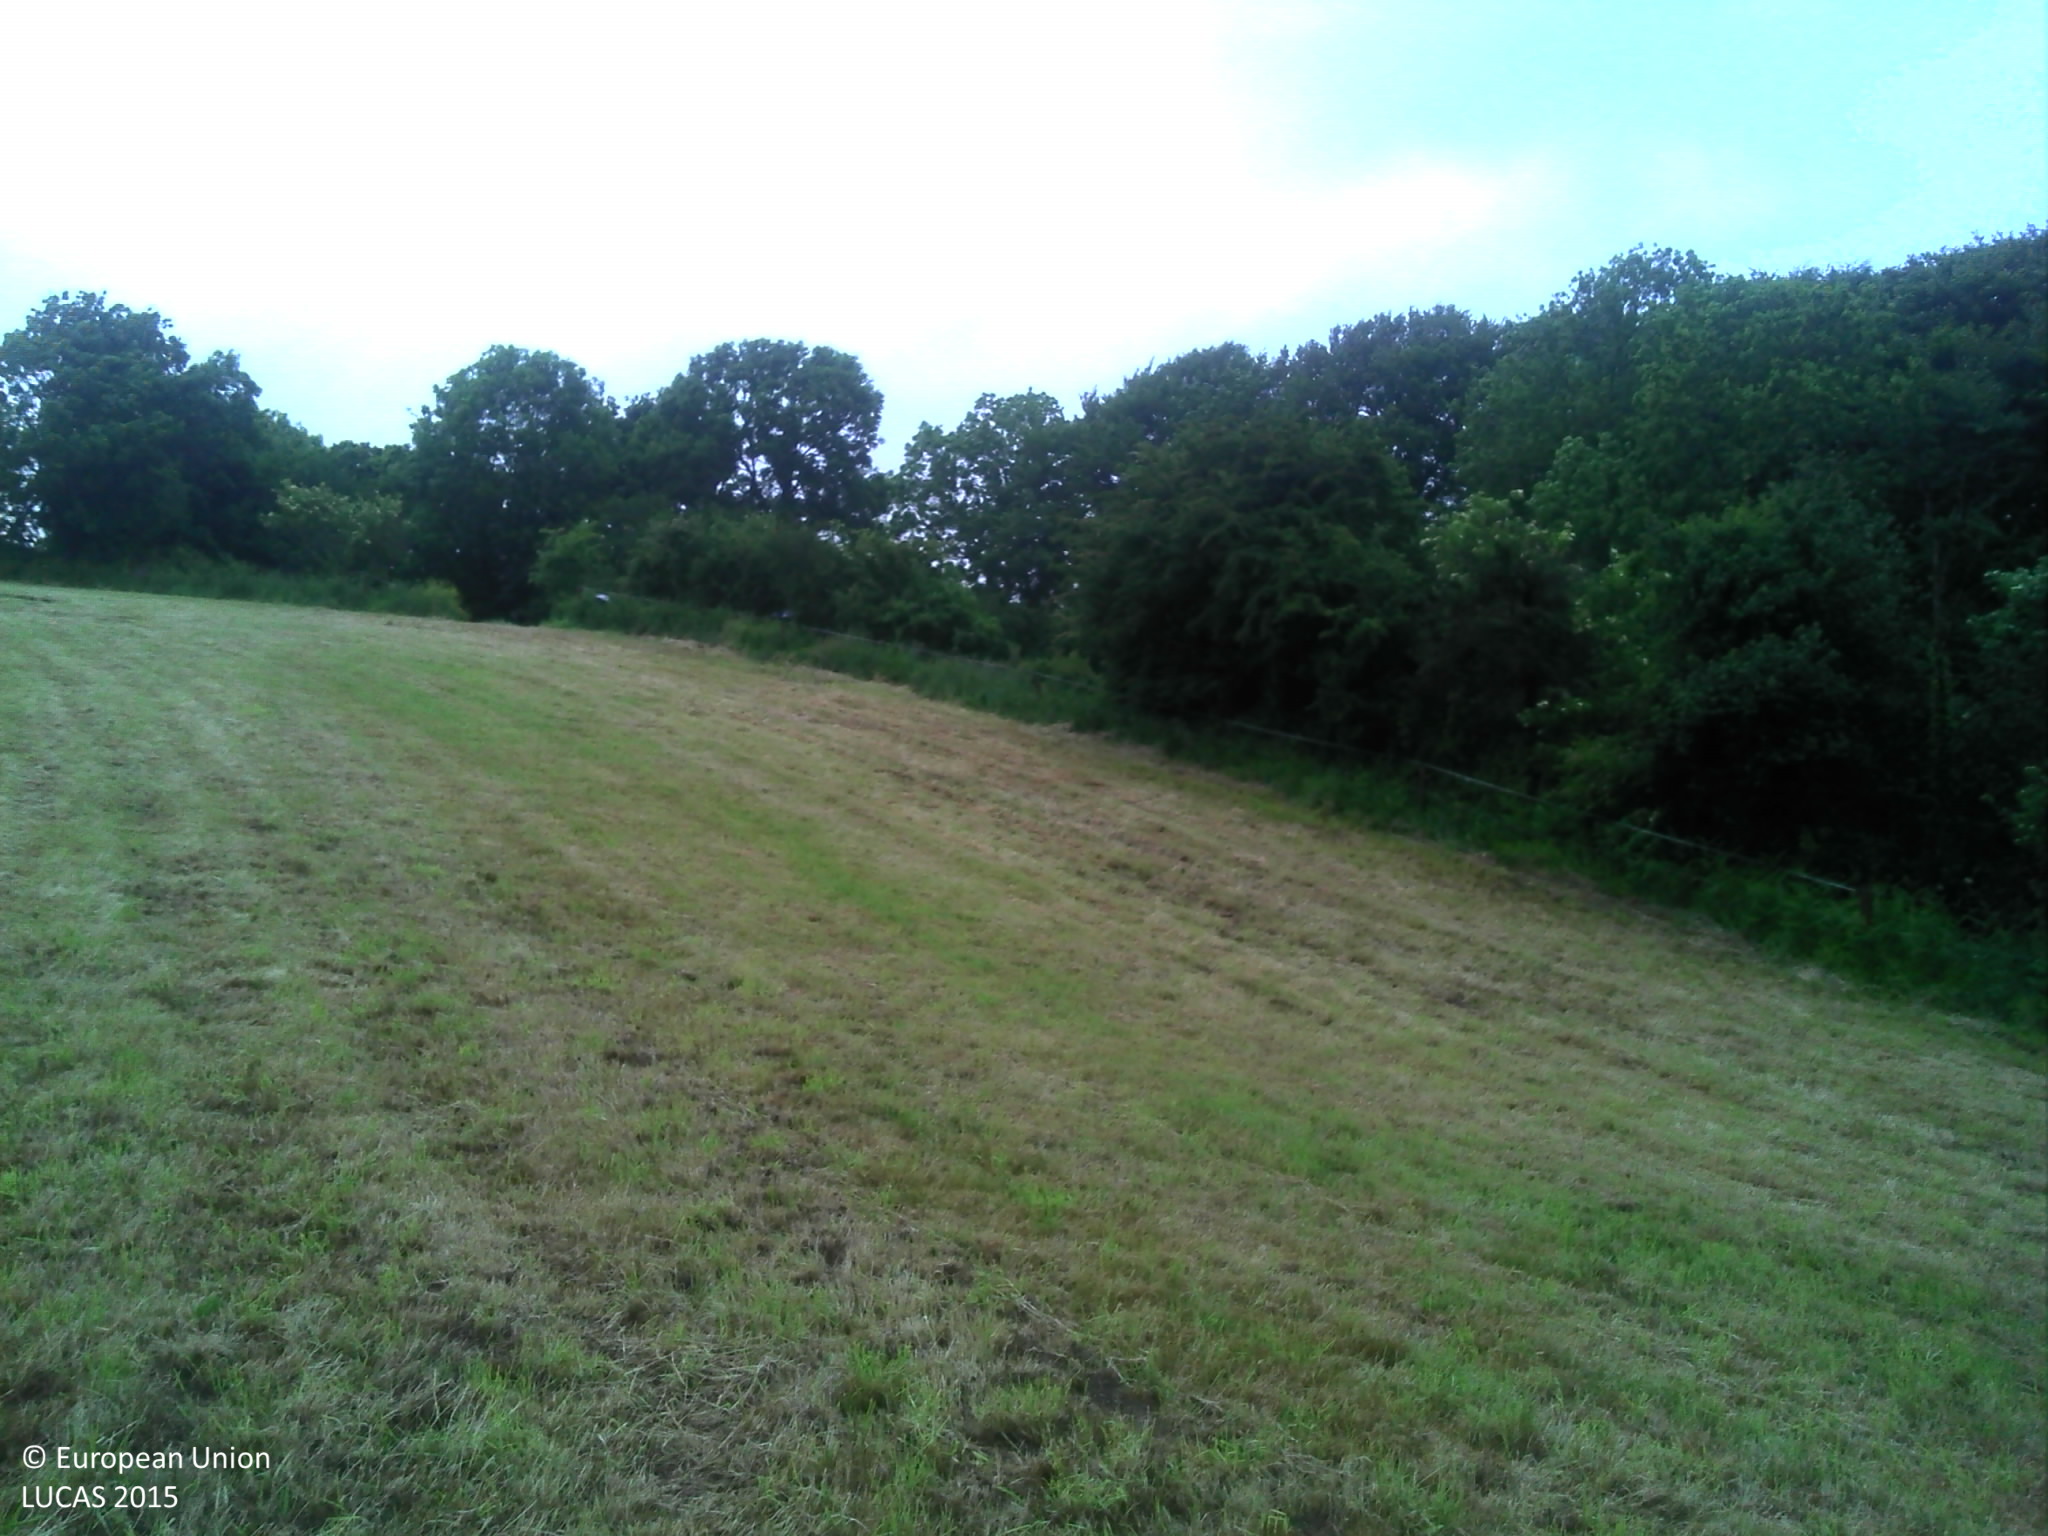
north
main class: Grassland
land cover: Grassland without tree/shrub cover
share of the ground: > 75 %
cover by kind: herbaceous plants 100 %
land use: Agriculture (excluding fallow land and kitchen gardens)
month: June
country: FR
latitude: 49.5668
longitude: -1.8207
